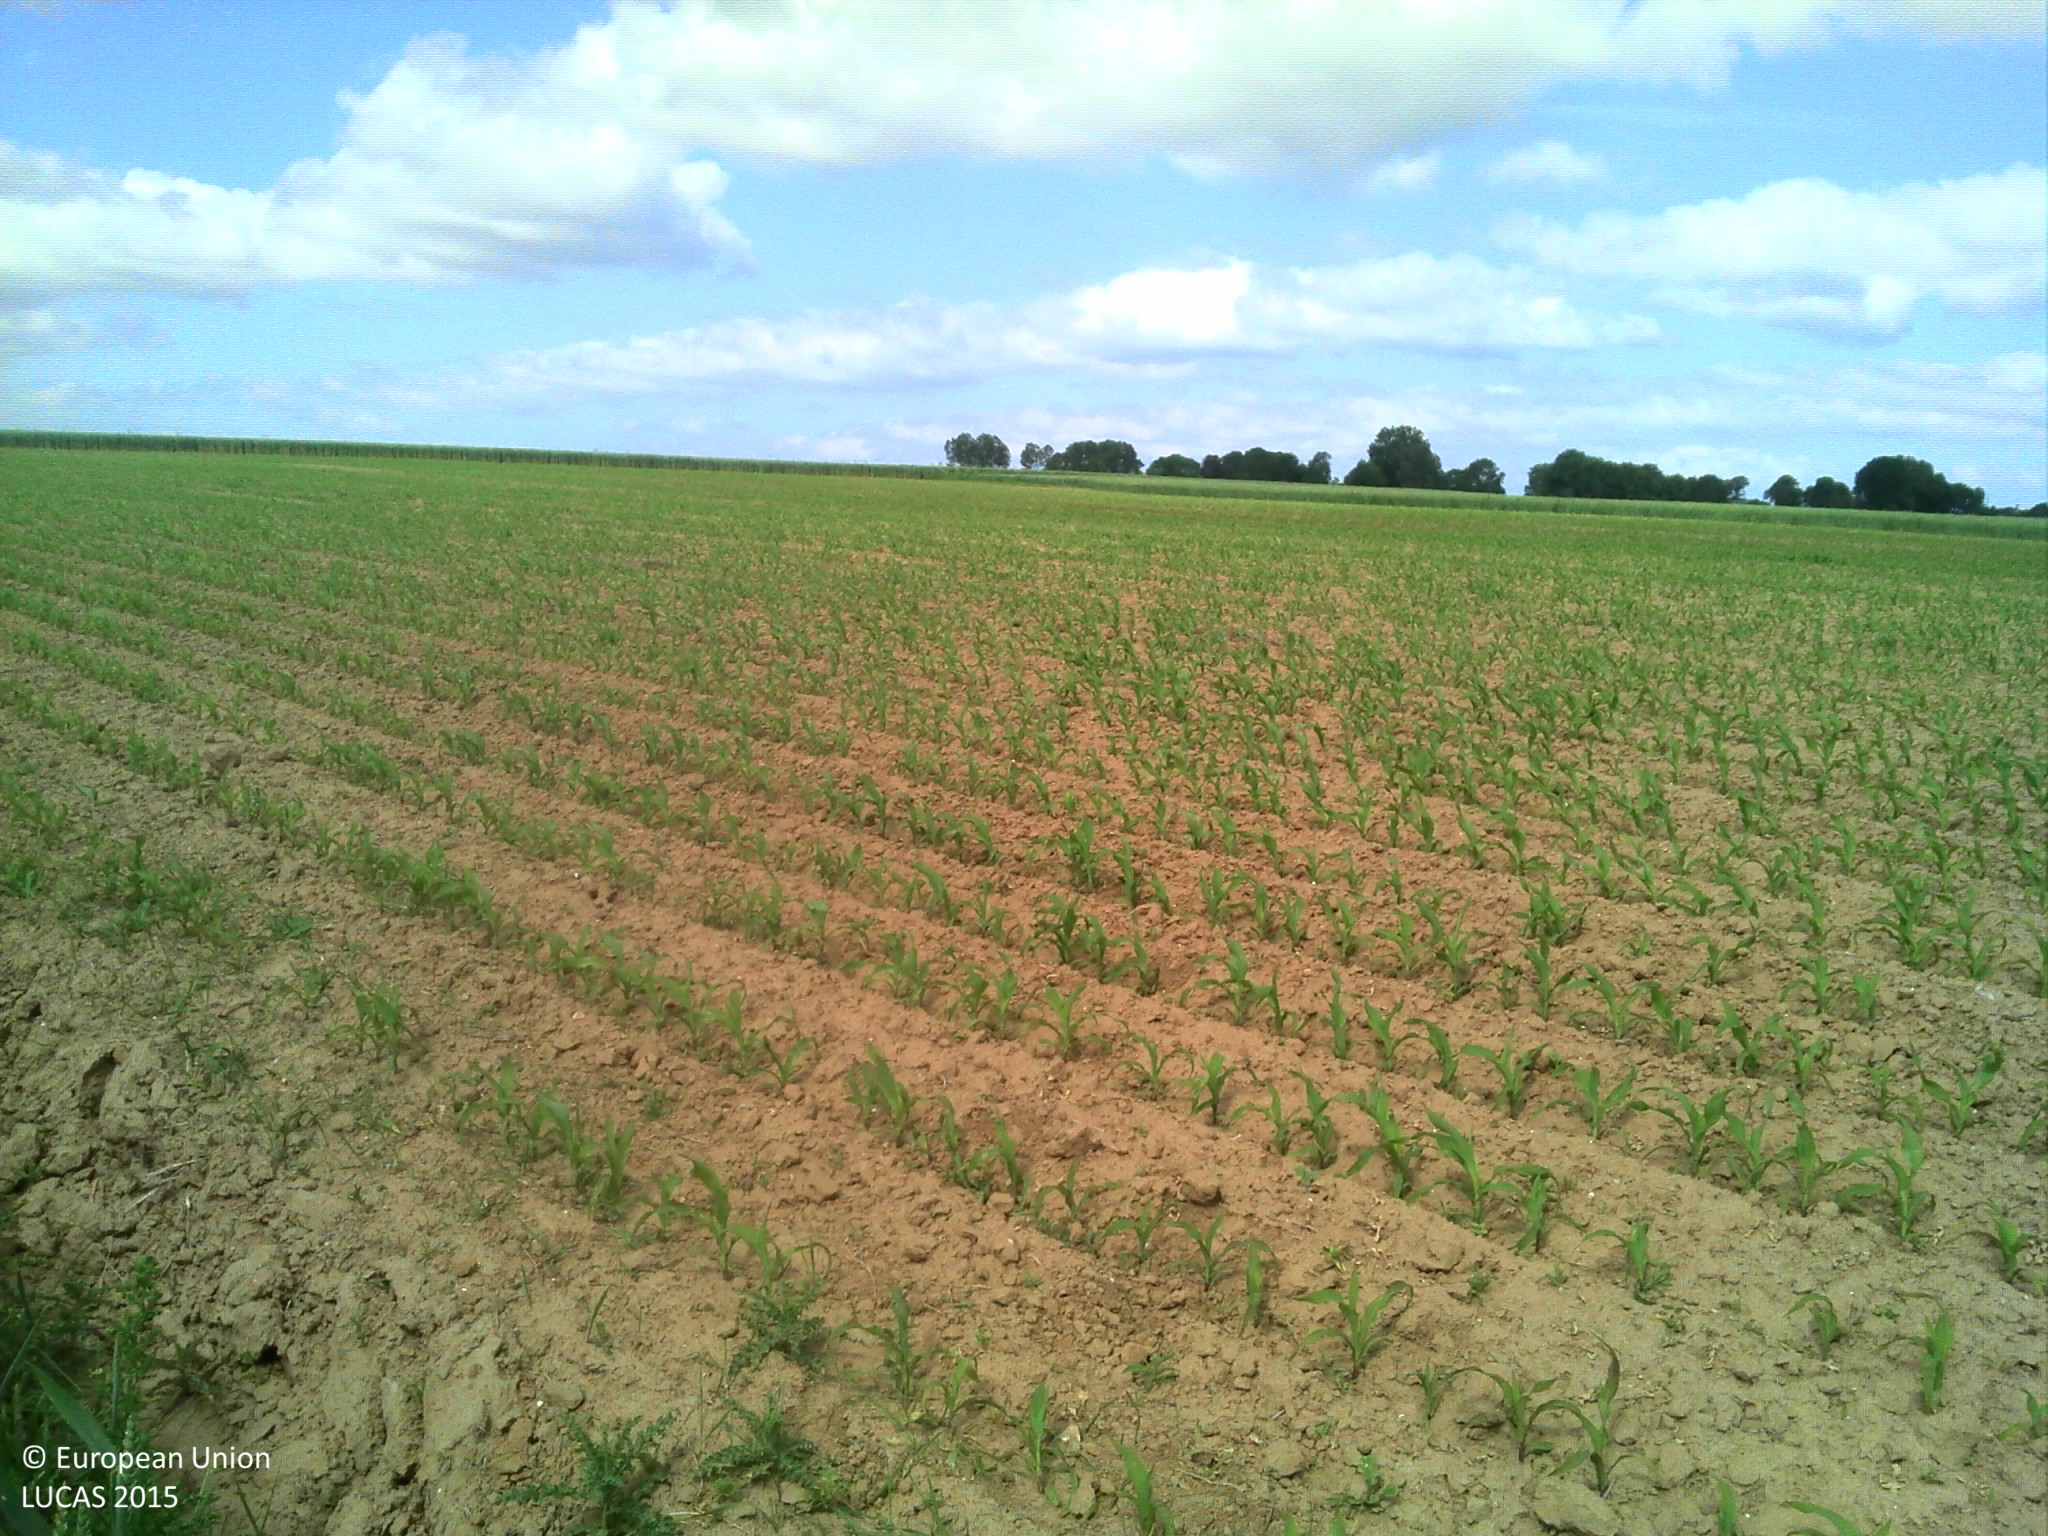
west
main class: Cropland
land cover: Common wheat
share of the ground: > 75 %
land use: Agriculture (excluding fallow land and kitchen gardens)
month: June
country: FR
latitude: 50.1073
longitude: 1.5782
